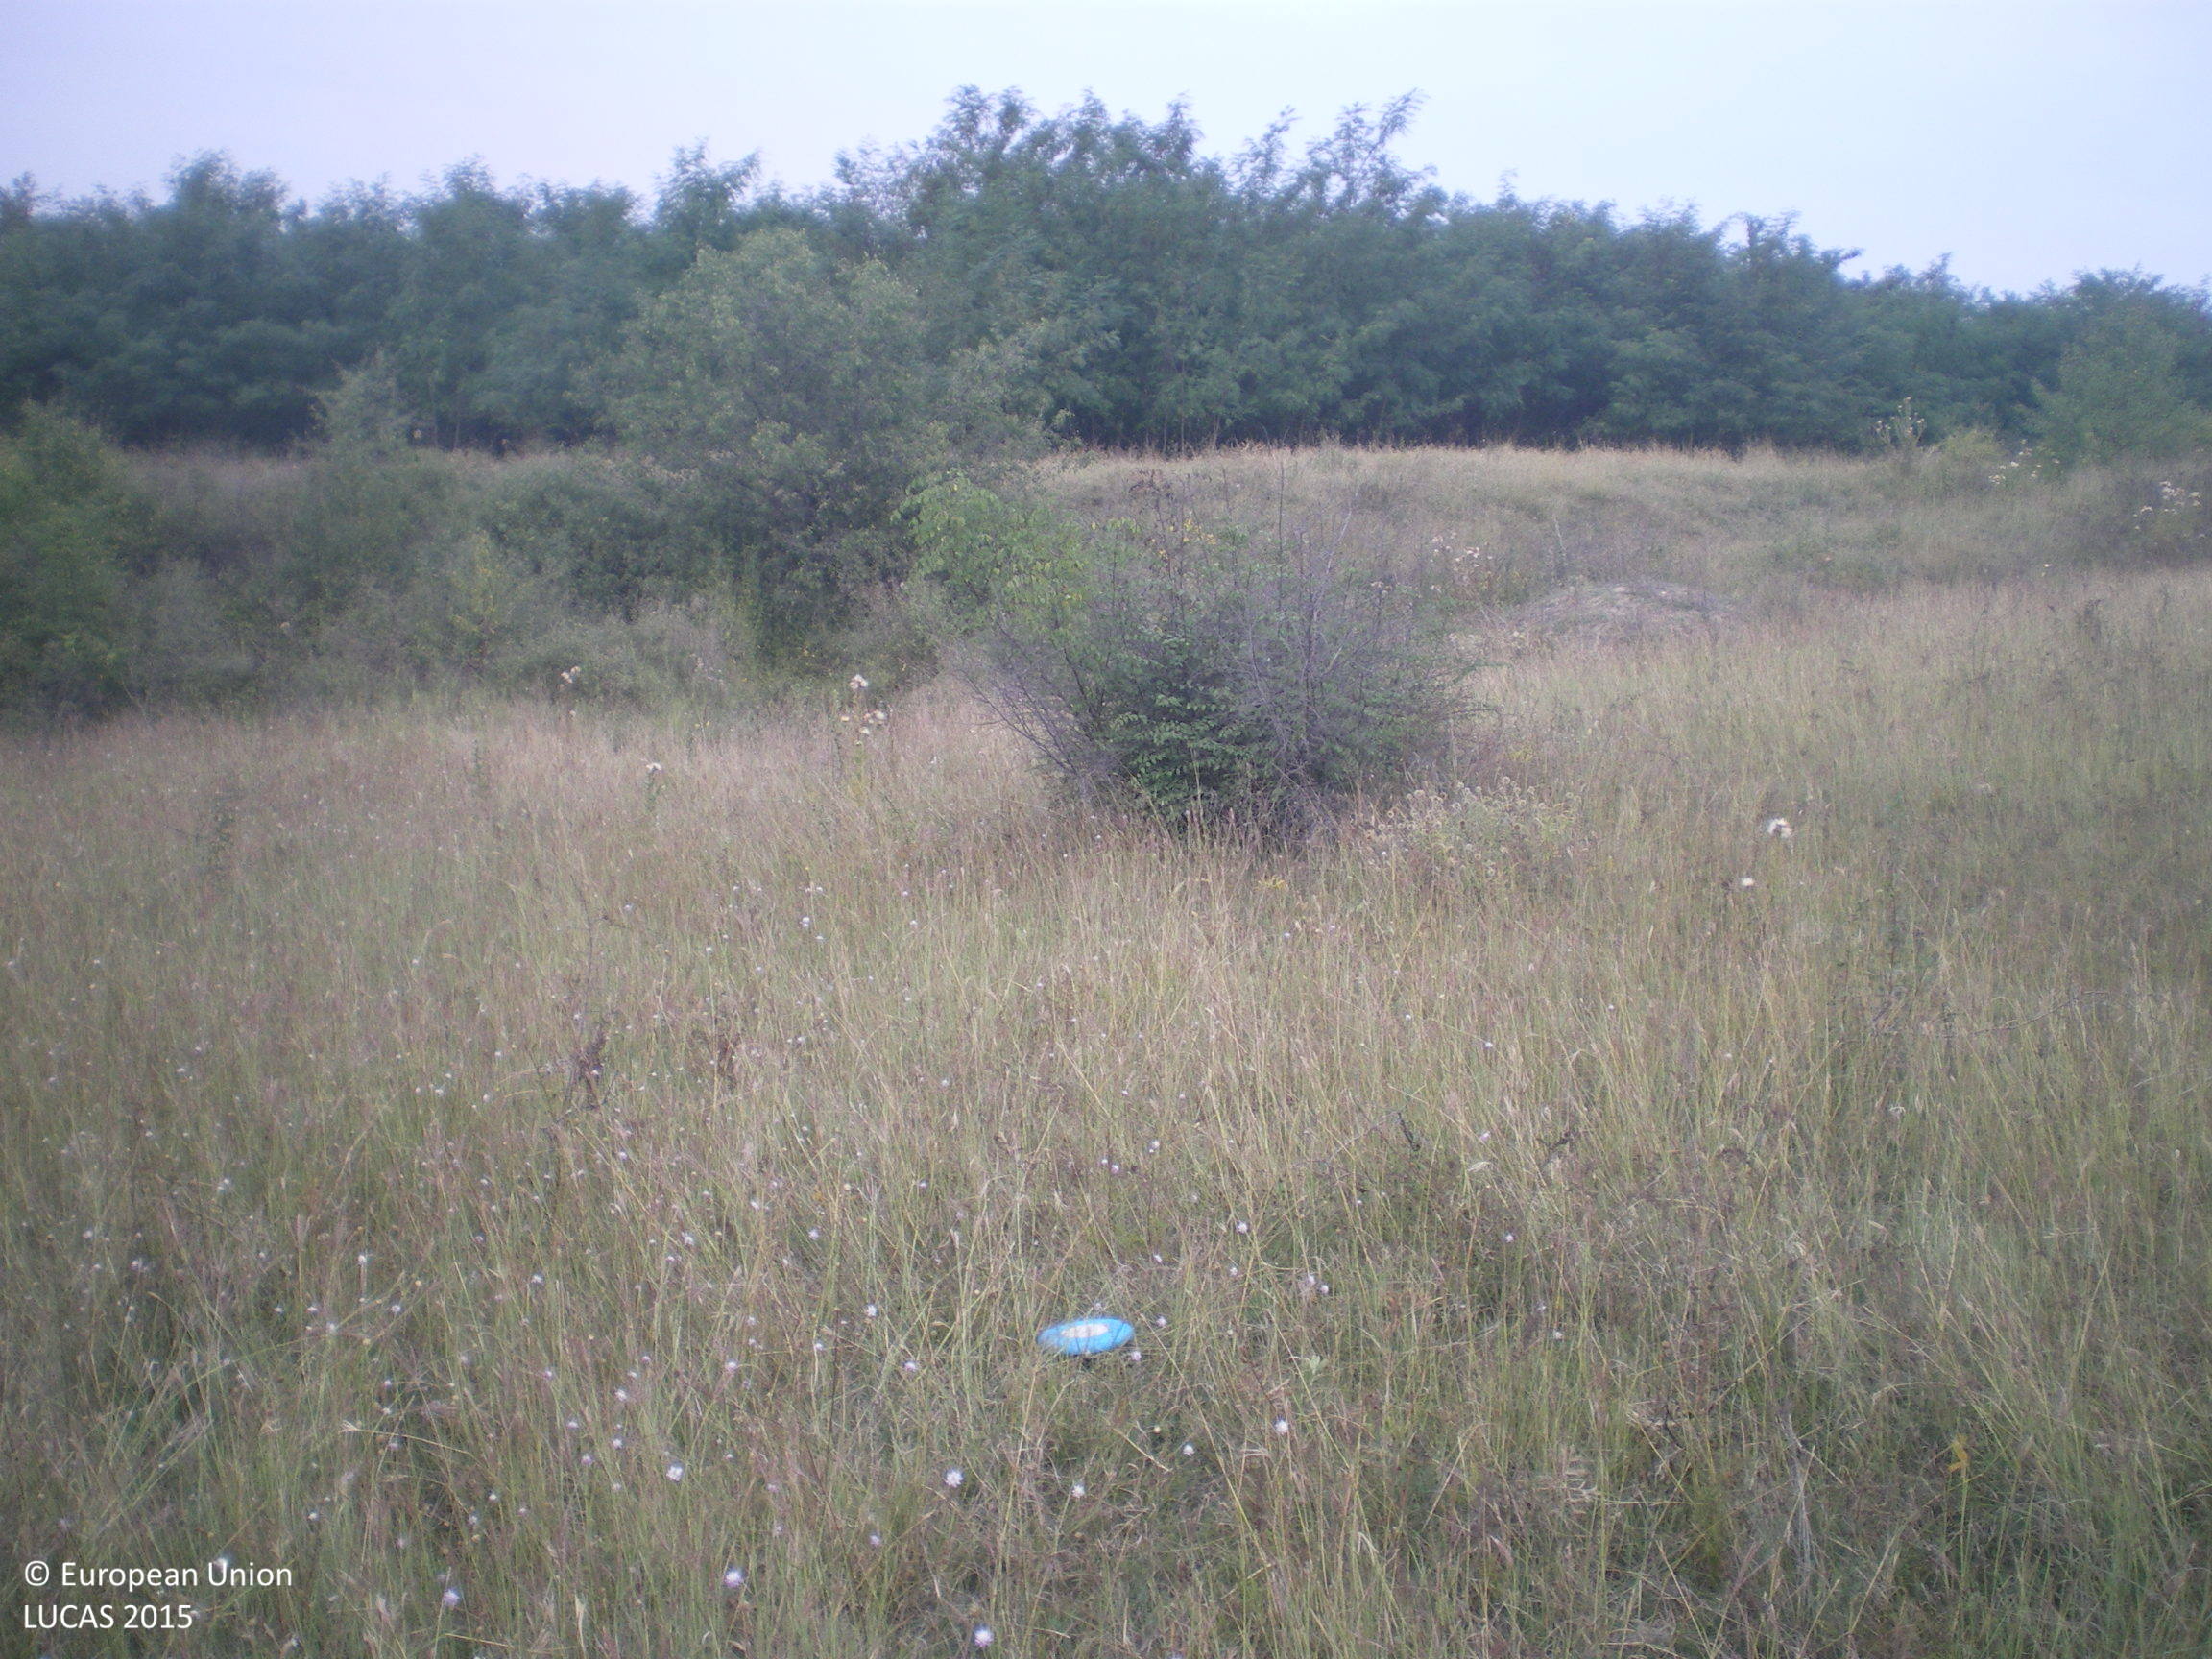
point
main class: Grassland
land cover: Grassland with sparse tree/shrub cover
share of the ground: > 75 %
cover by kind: herbaceous plants 90 %, broadleaved forest trees 5 %, shrubs 5 %
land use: Agriculture (excluding fallow land and kitchen gardens)
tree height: > 5 m
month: September
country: BG
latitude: 42.1323
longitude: 25.9598
